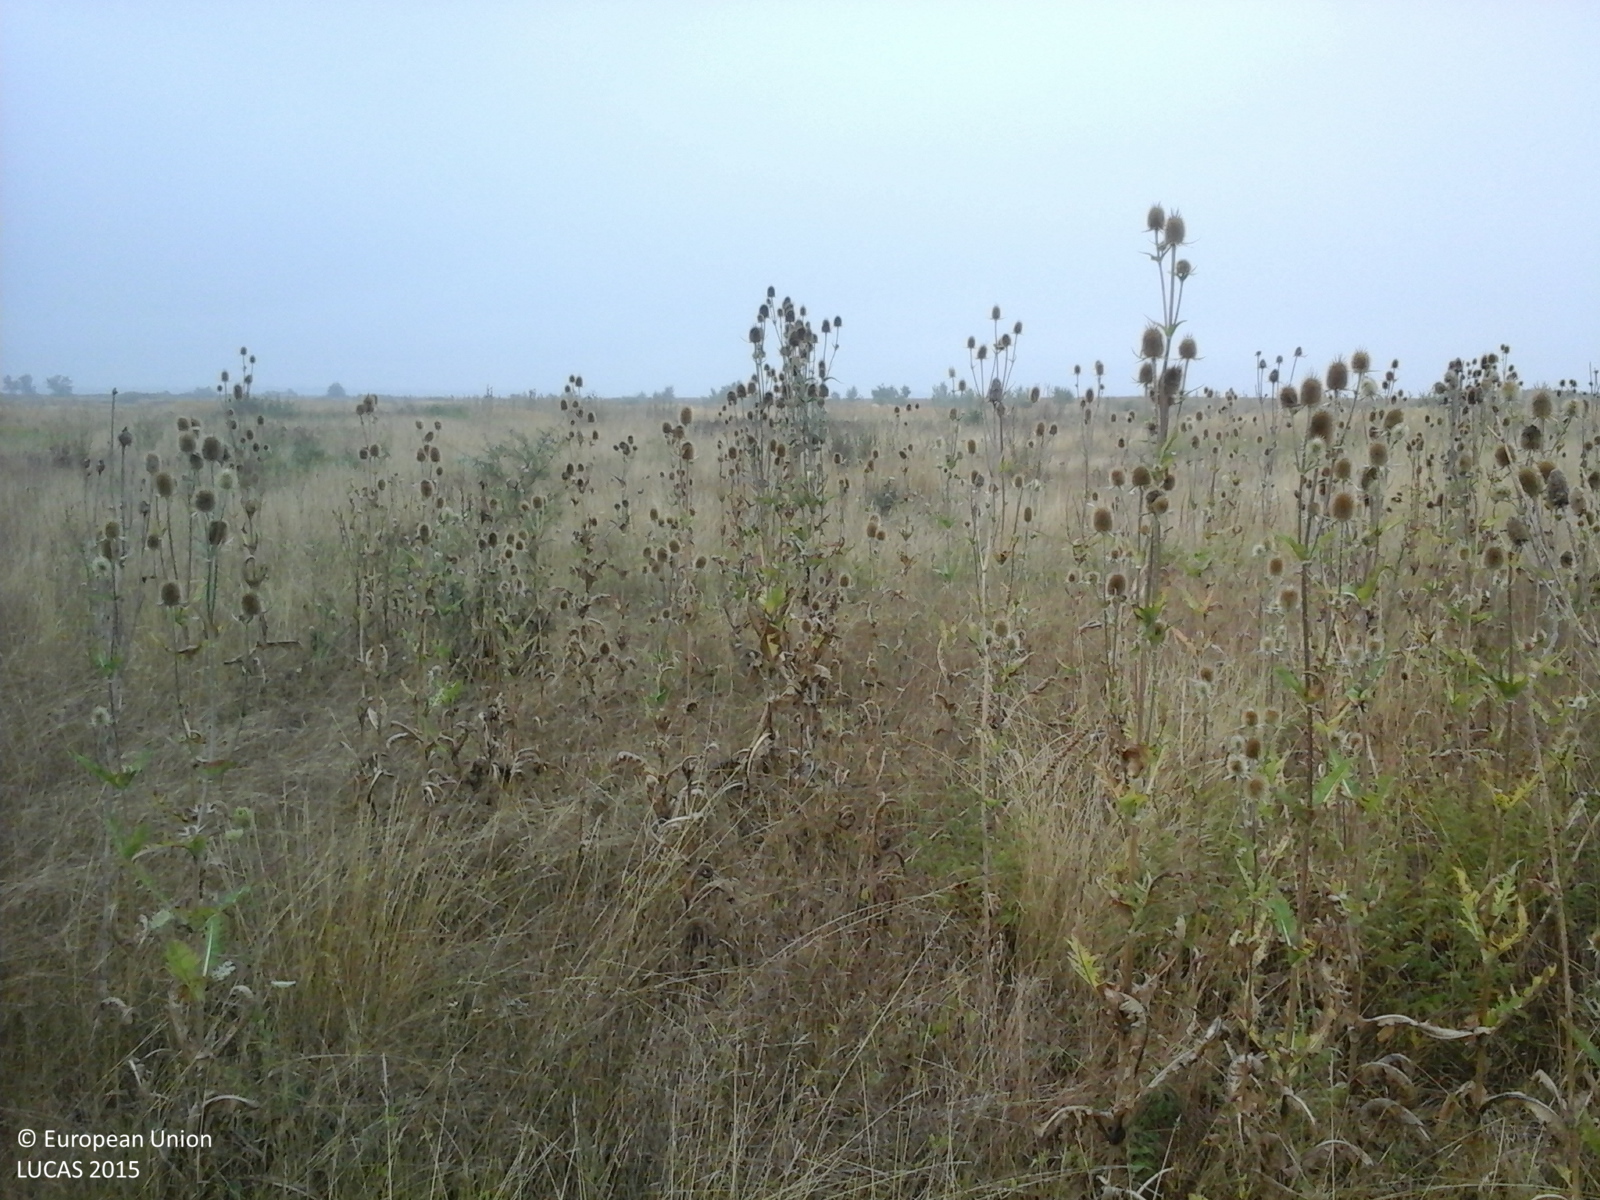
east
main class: Grassland
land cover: Spontaneously vegetated surfaces
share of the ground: > 75 %
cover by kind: herbaceous plants 100 %
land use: Fallow land
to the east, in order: Spontaneously vegetated surfaces
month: August
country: RO
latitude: 46.0701
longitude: 20.8495
